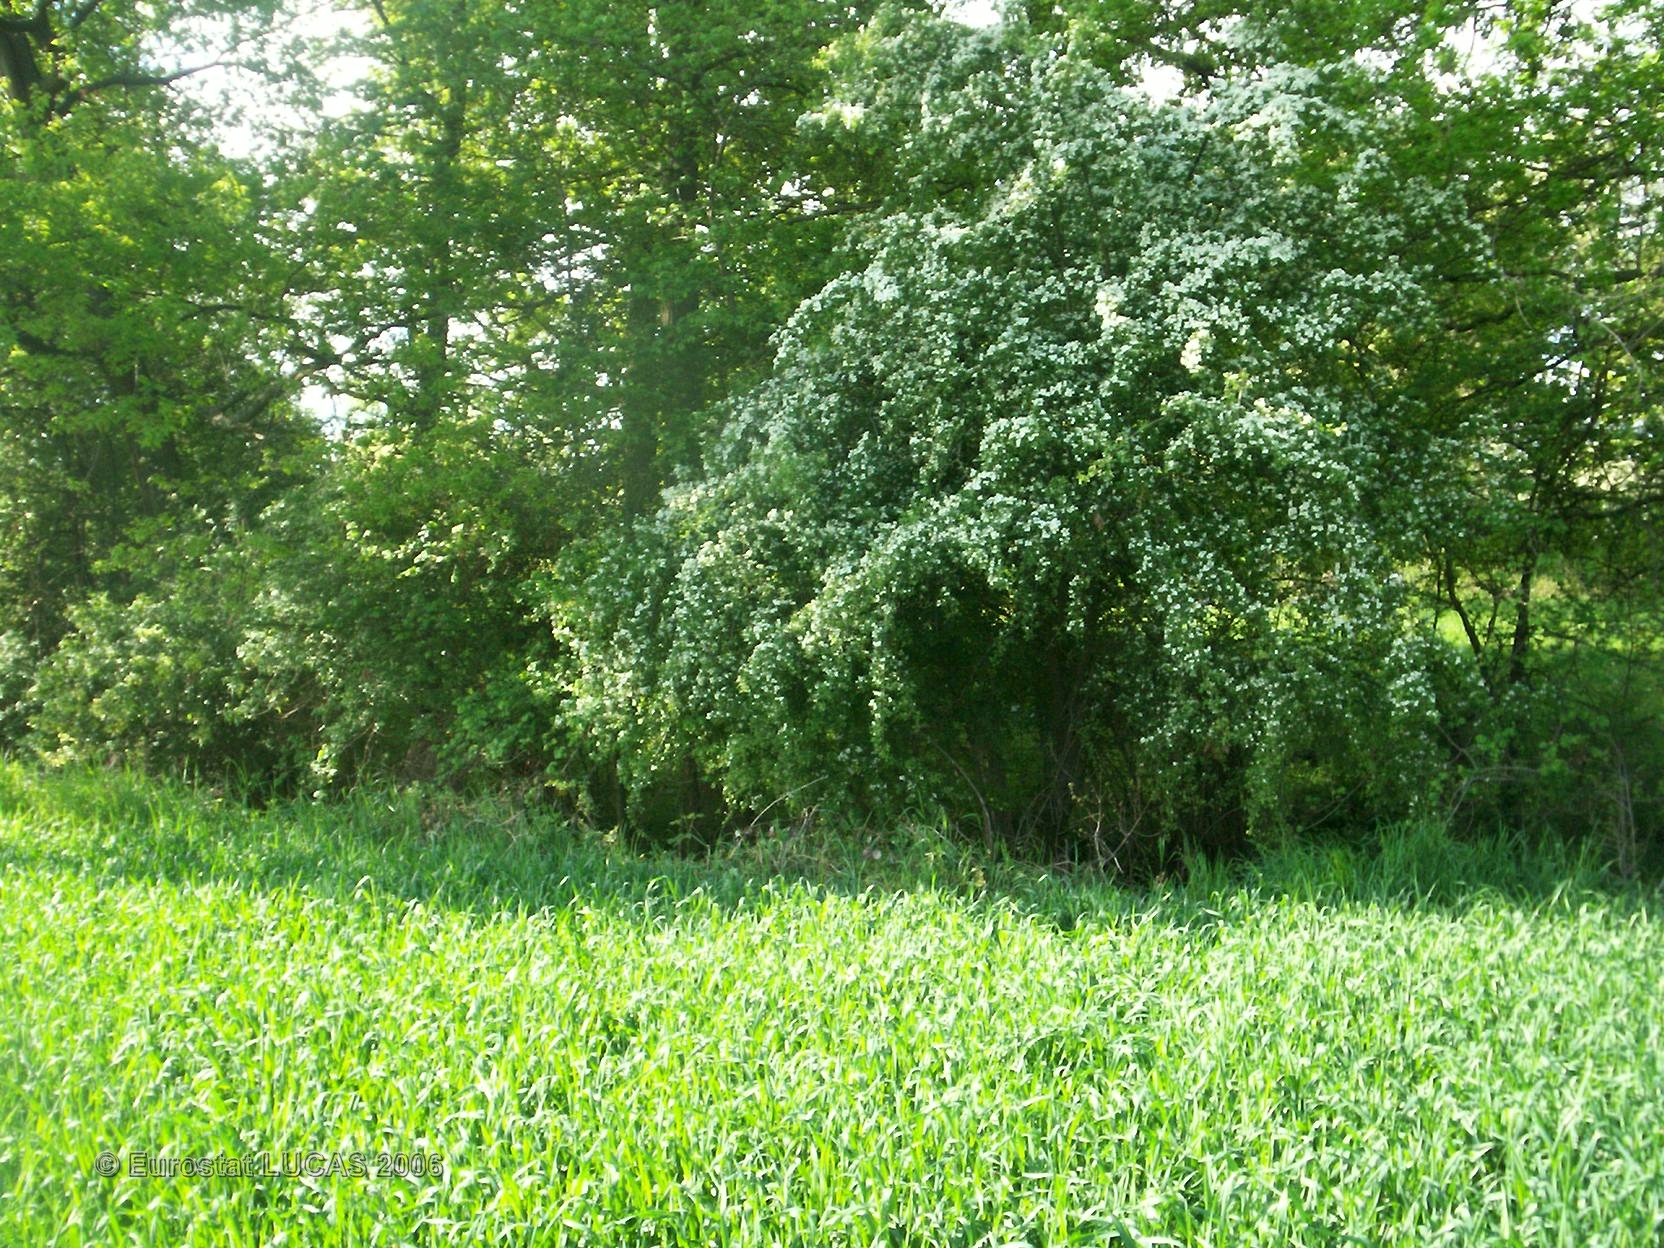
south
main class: Cropland
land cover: Common wheat
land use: Agriculture (excluding fallow land and kitchen gardens)
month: May
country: FR
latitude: 45.8986
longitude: 3.1814
